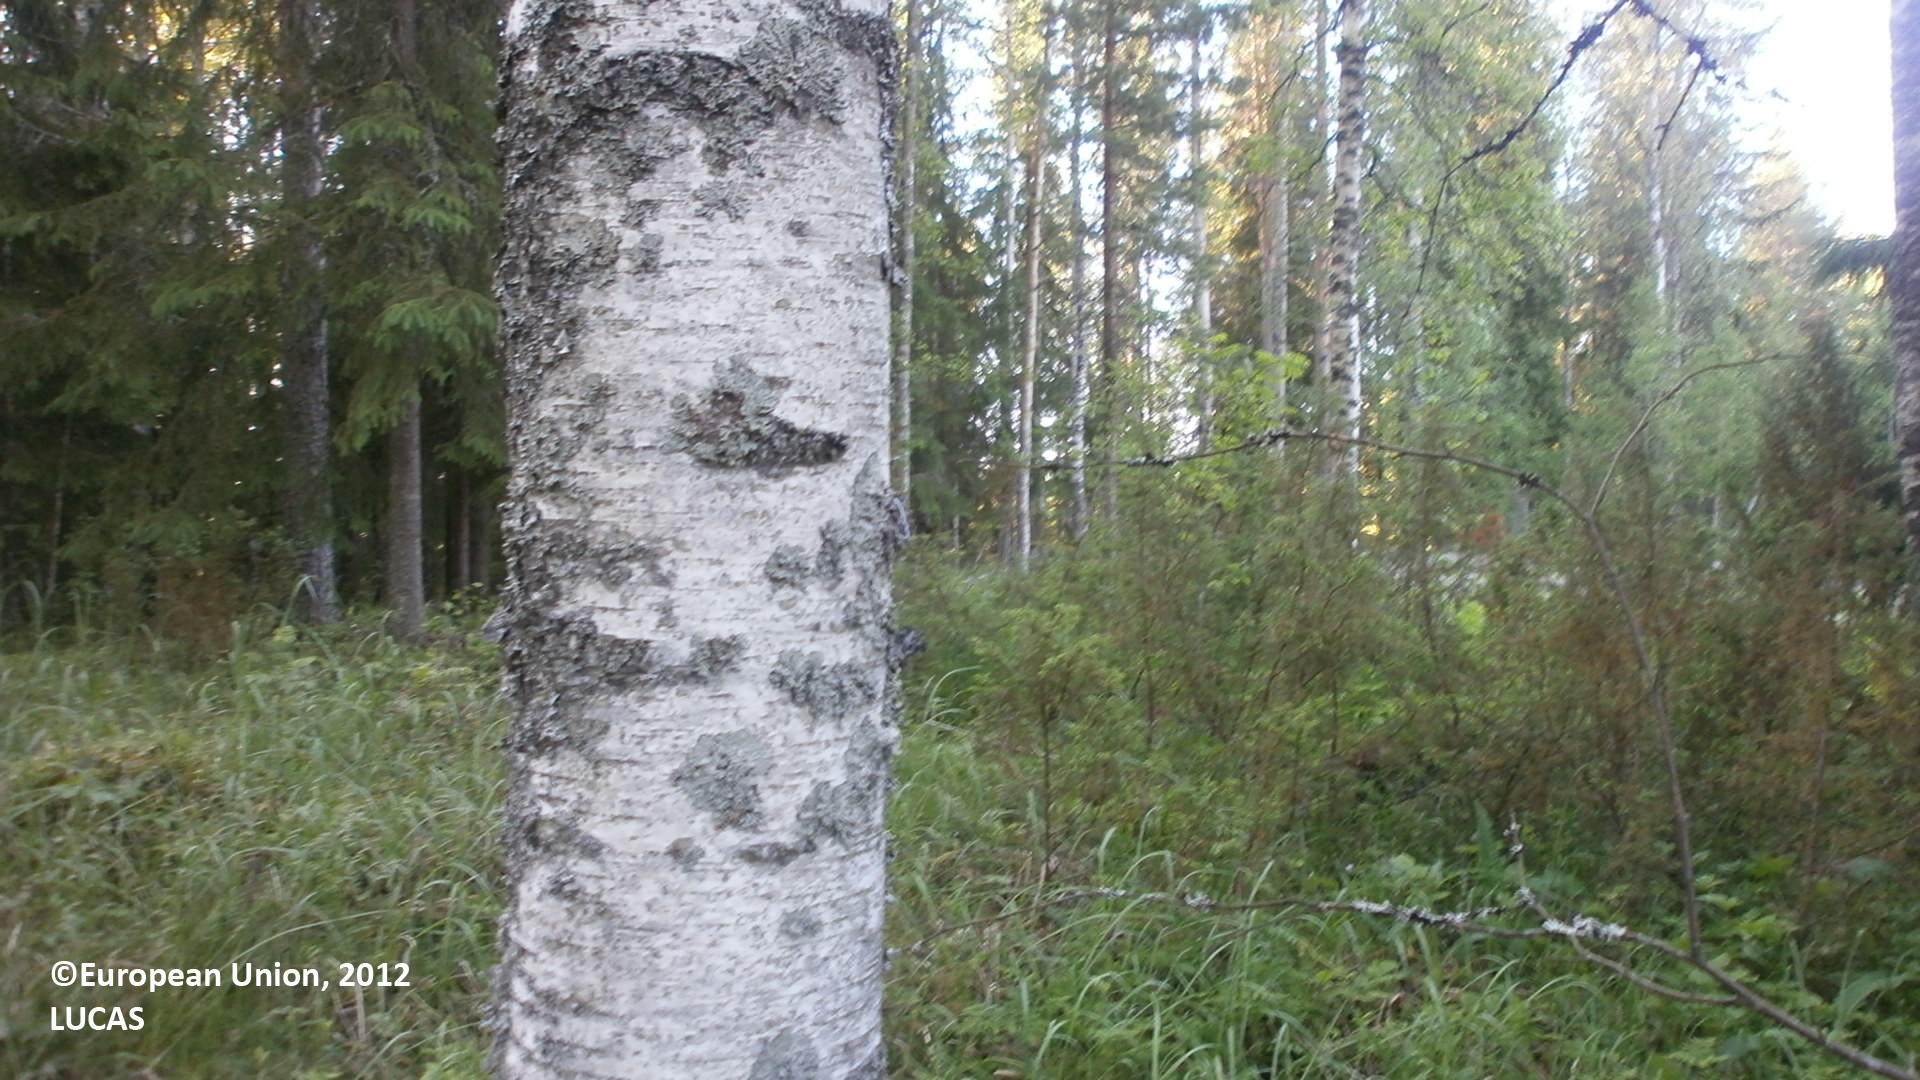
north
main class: Woodland
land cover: Other mixed woodland
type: boreal forest
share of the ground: > 75 %
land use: Amenities, museums, leisure
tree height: > 5 m
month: June
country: FI
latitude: 64.3121
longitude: 24.9467
